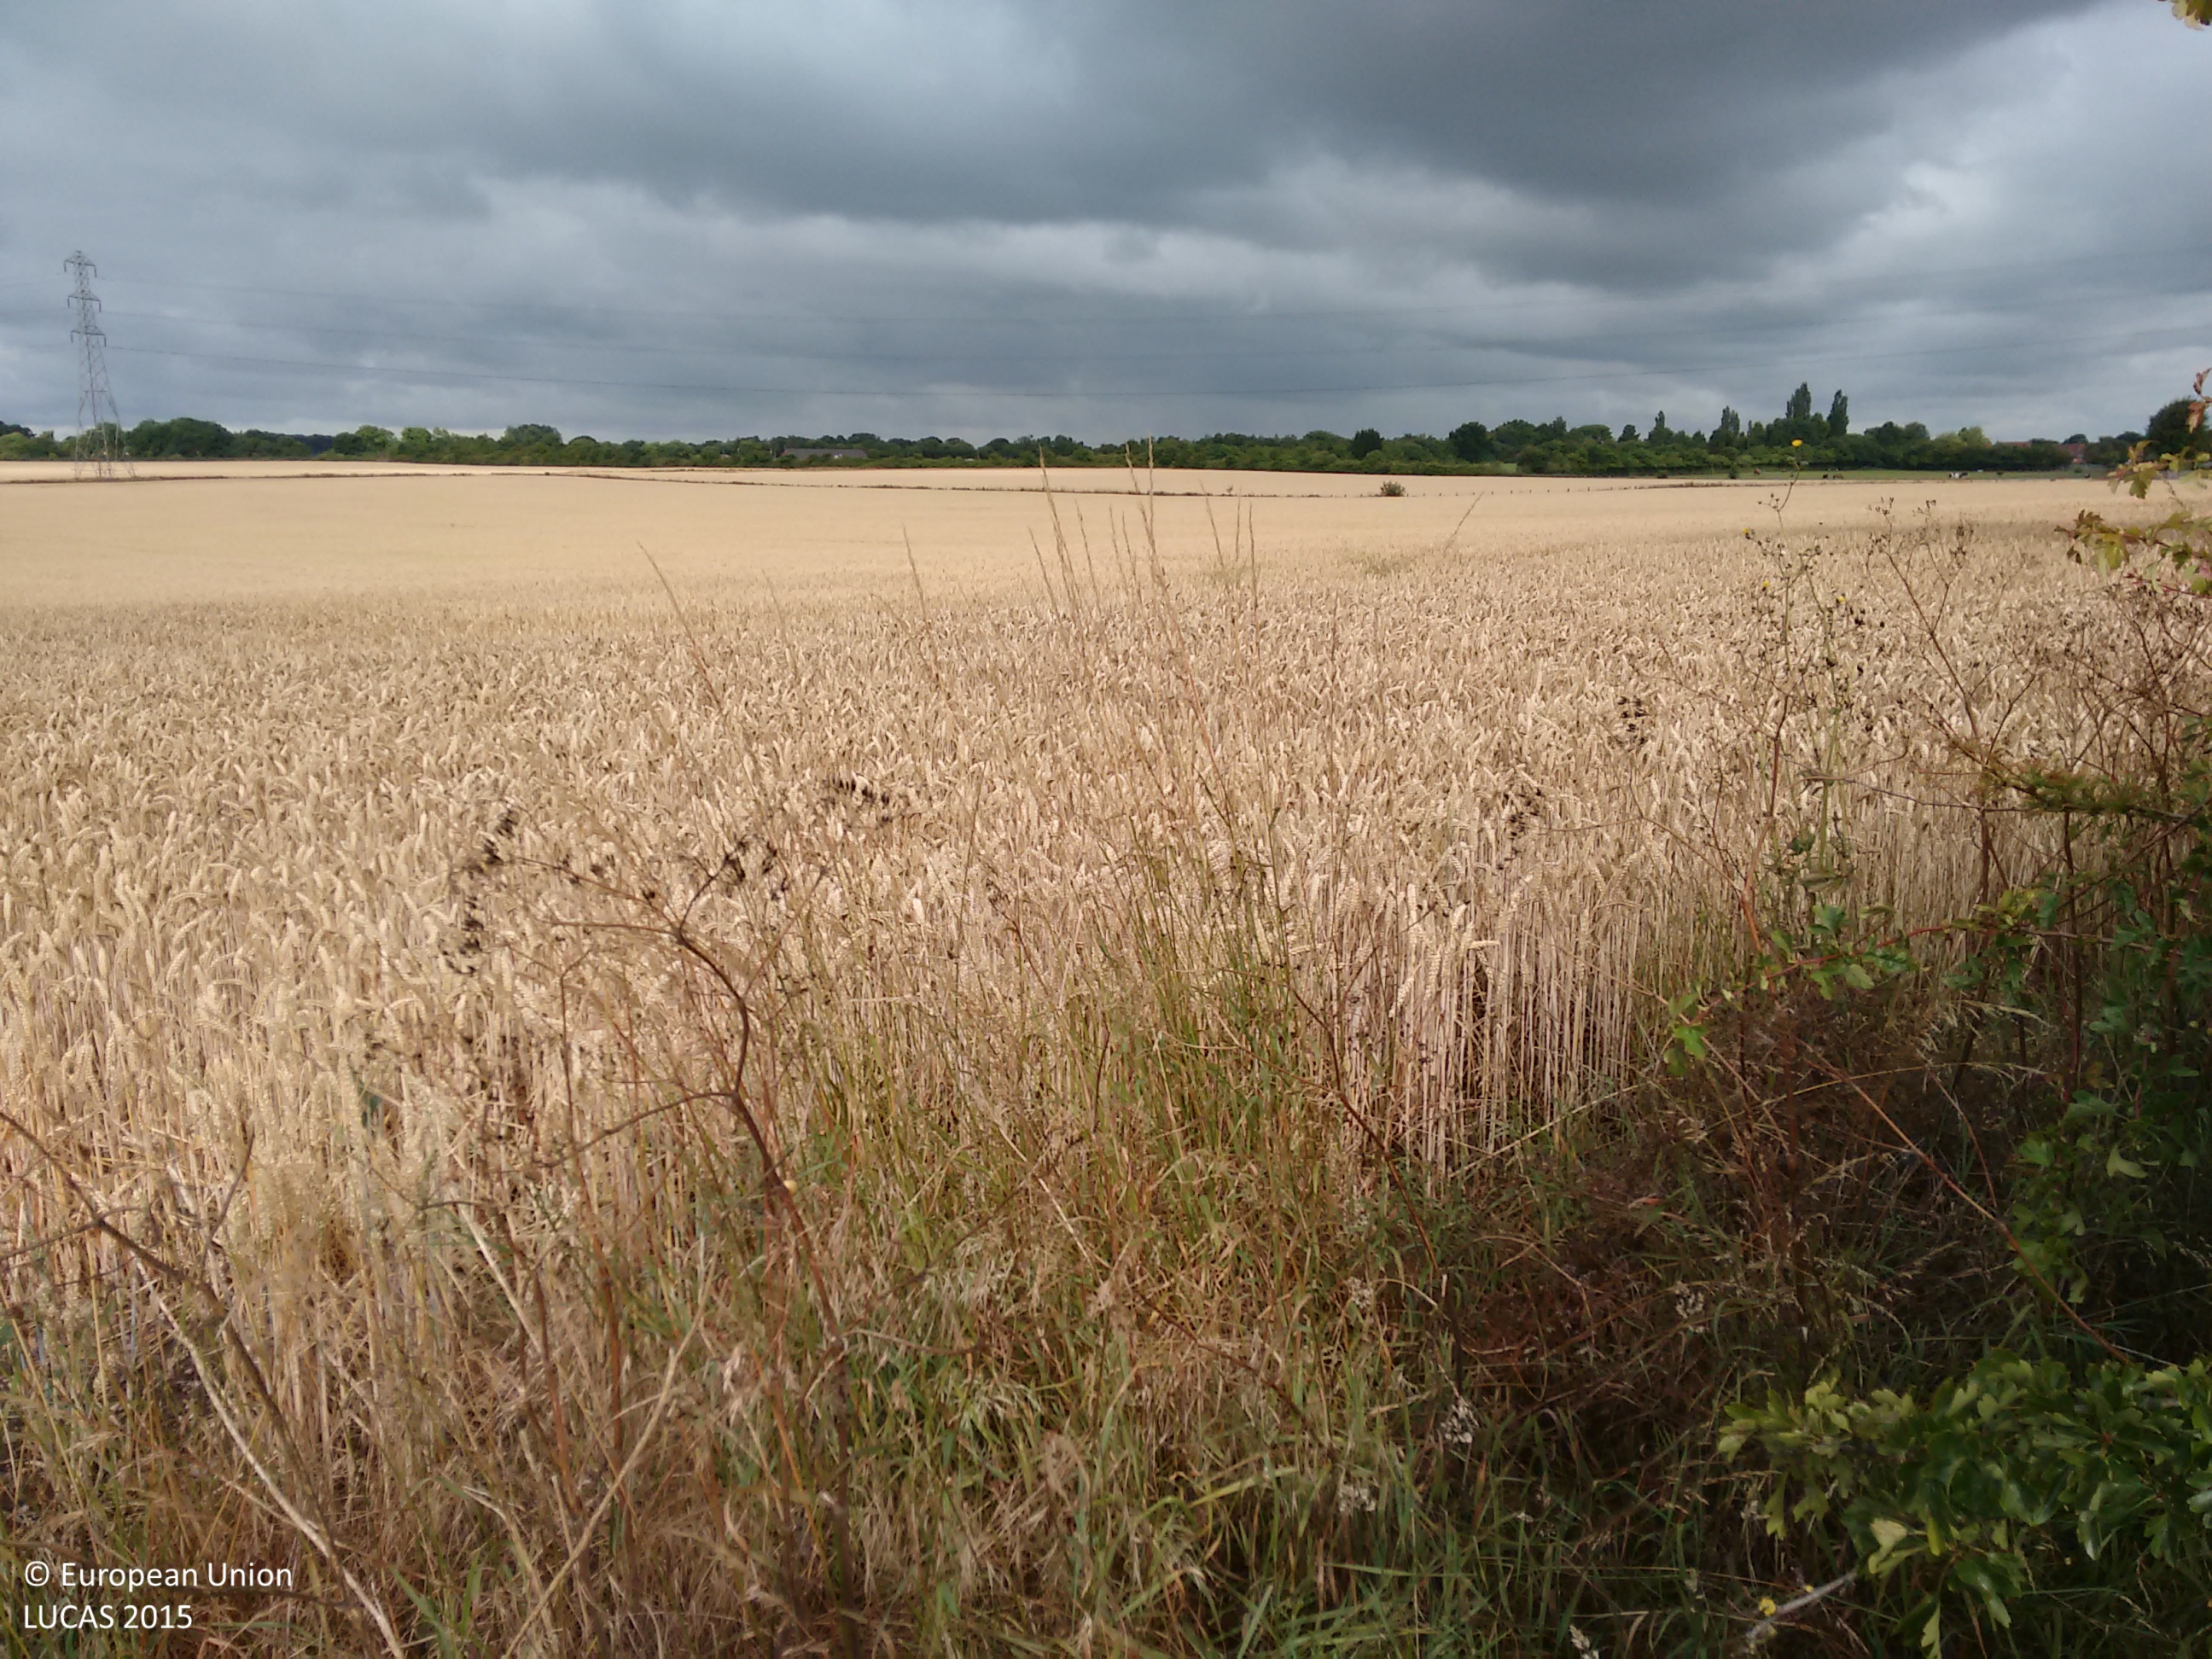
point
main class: Cropland
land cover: Common wheat
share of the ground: > 75 %
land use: Agriculture (excluding fallow land and kitchen gardens)
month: July
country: GB
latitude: 52.6376
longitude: -2.0130
